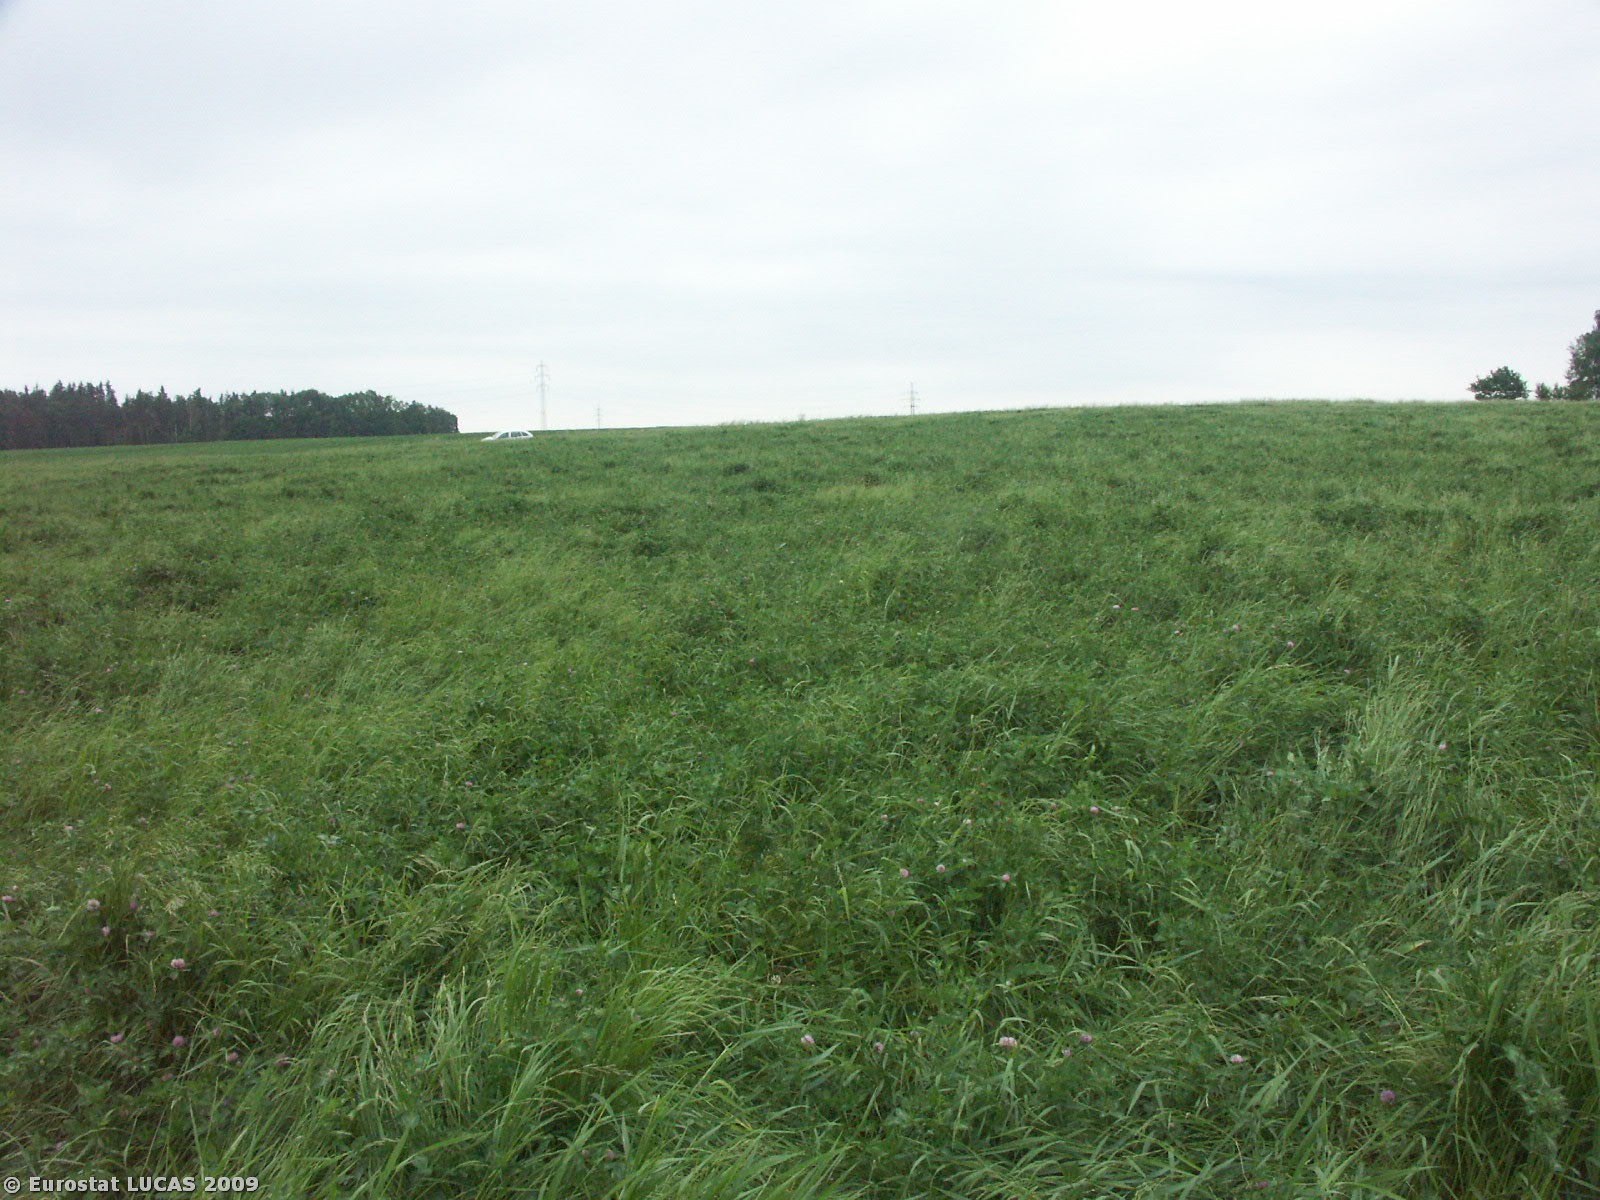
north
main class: Cropland
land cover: Temporary grasslands
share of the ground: 50 - 75 %
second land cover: Clovers
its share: 50 - 75 %
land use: Agriculture (excluding fallow land and kitchen gardens)
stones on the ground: < 10 %
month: May
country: CZ
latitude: 48.8912
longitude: 14.4337
